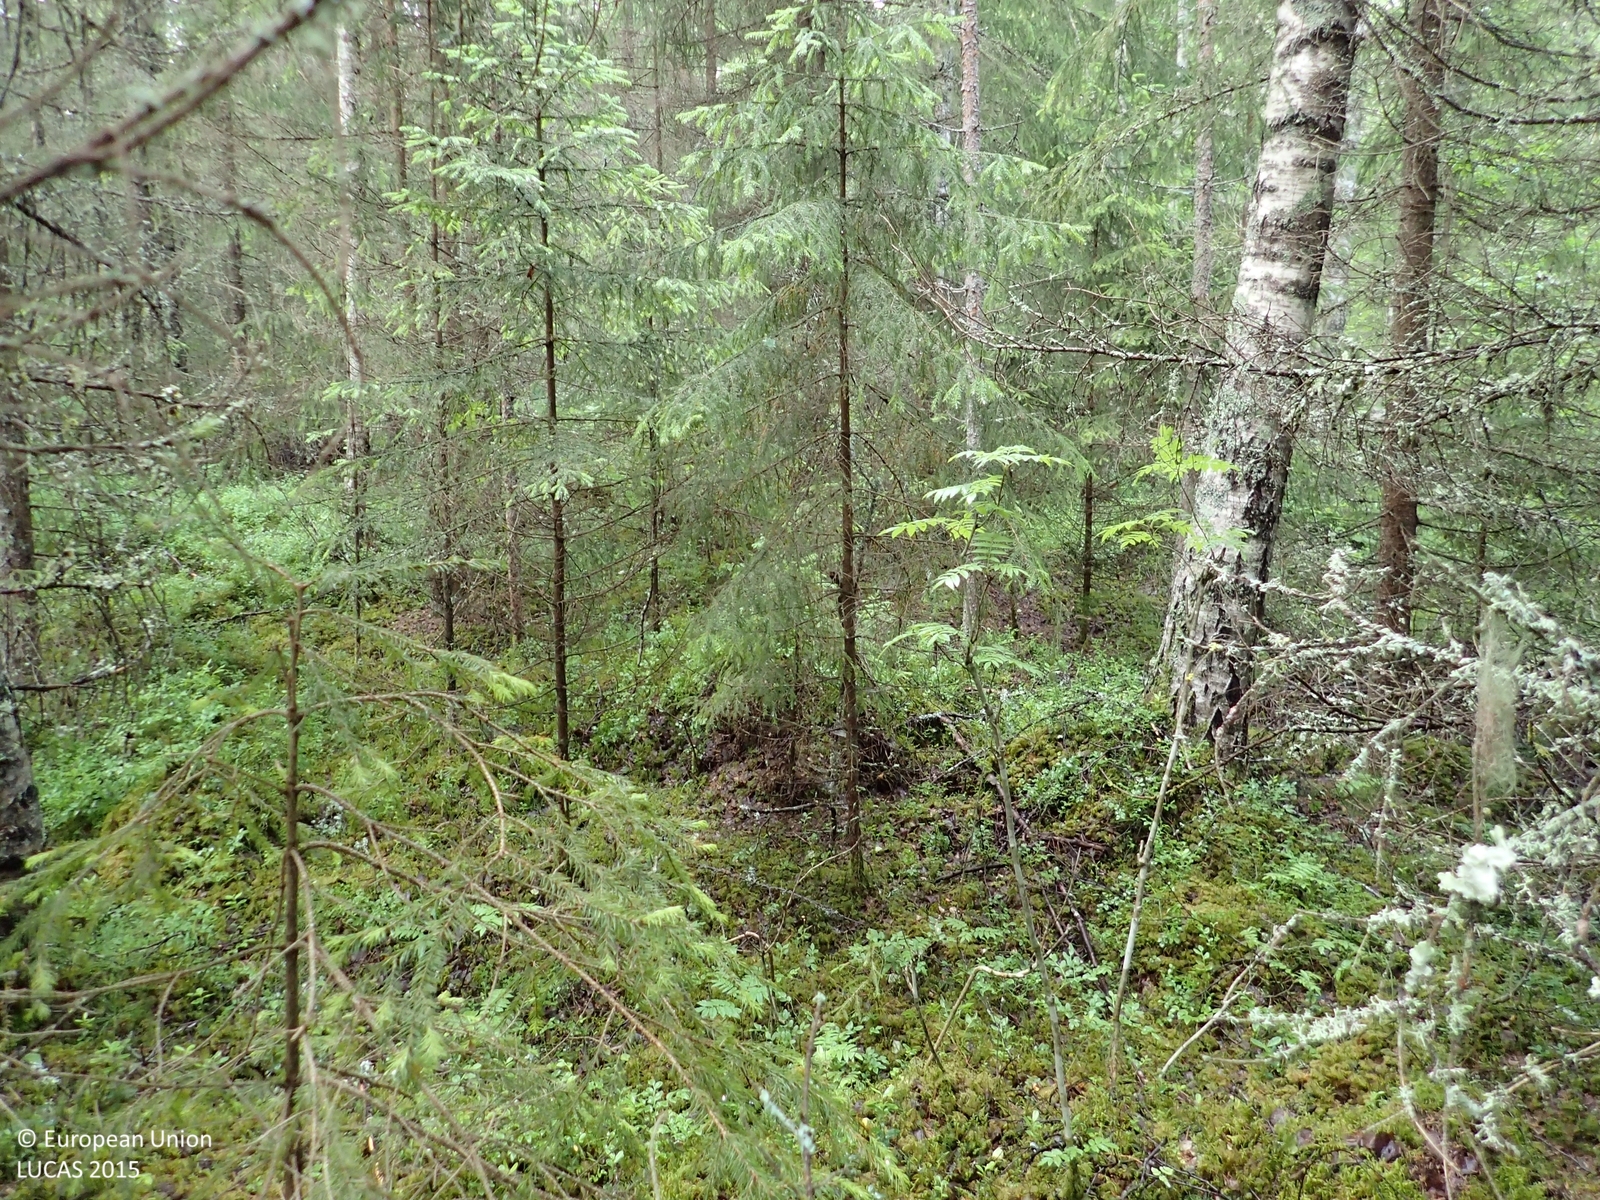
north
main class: Woodland
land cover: Spruce dominated coniferous woodland
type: boreal forest
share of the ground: > 75 %
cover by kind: coniferous forest trees 75 %, broadleaved forest trees 10 %, shrubs 10 %, lichens and mosses 5 %
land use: Forestry
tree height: > 5 m
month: July
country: FI
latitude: 62.8791
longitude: 21.5434
